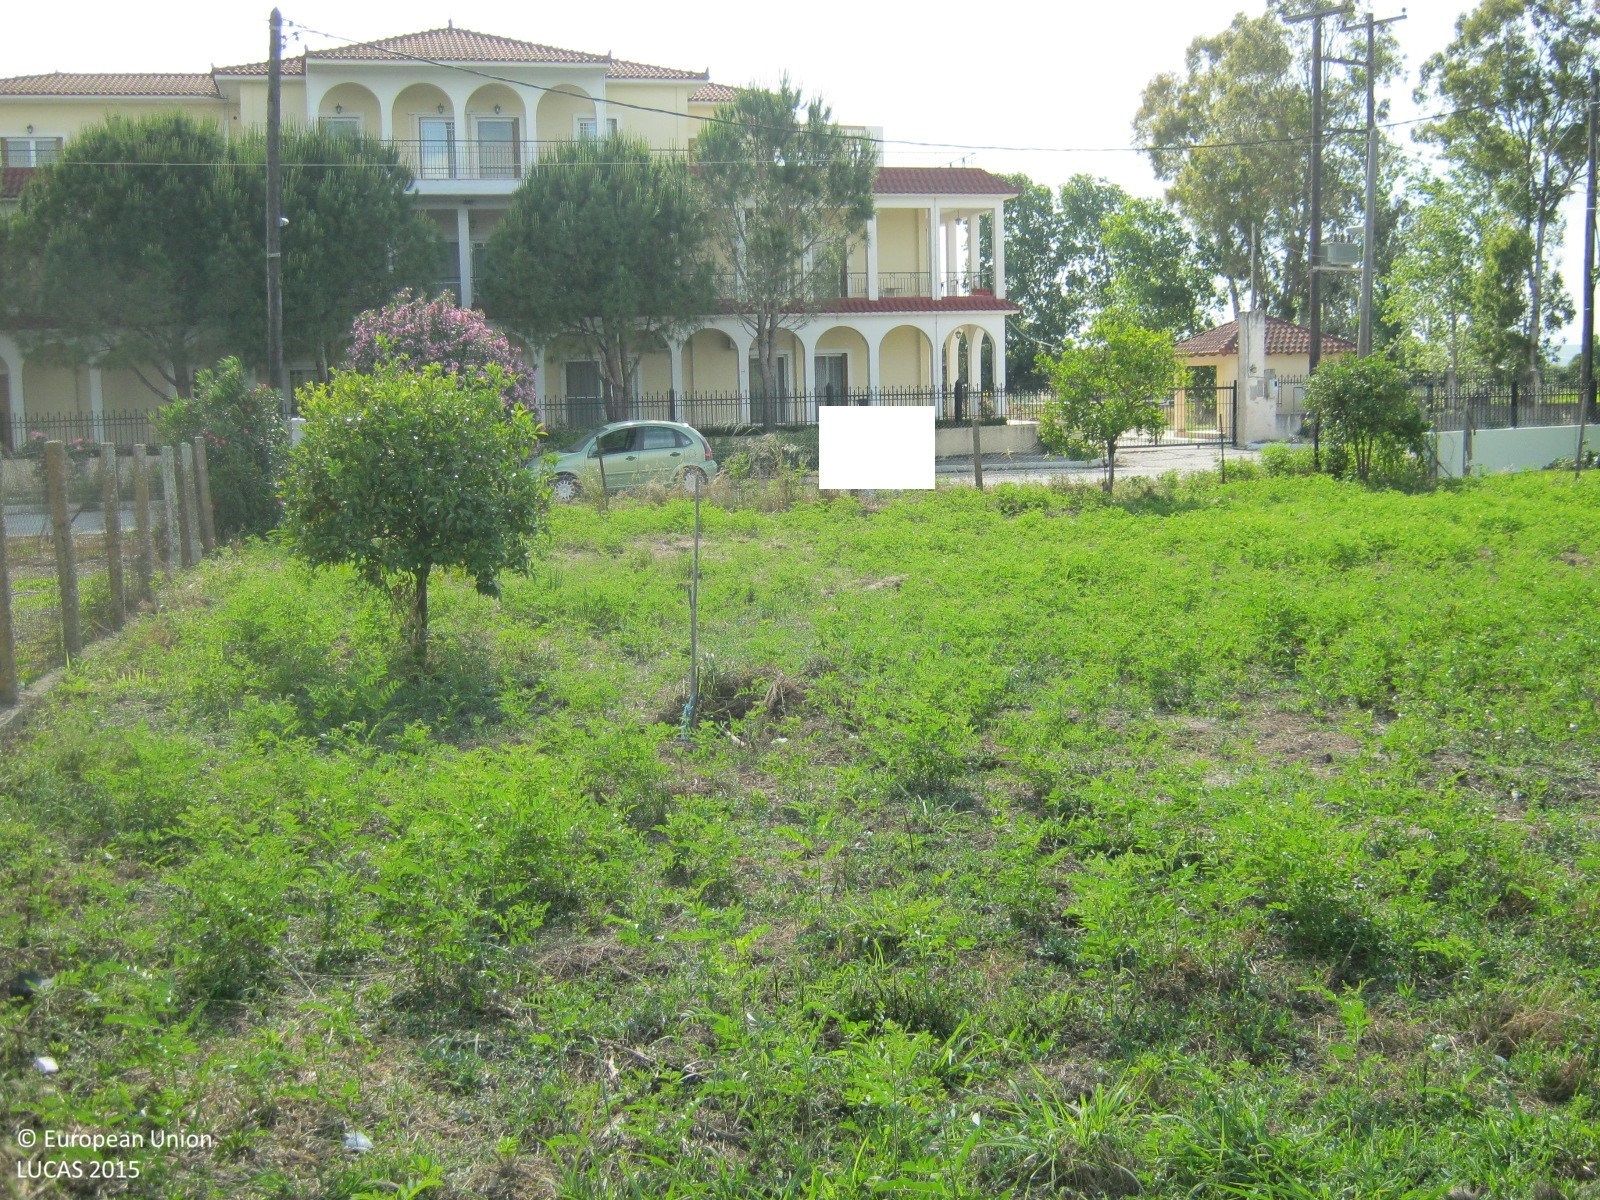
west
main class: Cropland
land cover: Oranges
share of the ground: 10 - 25 %
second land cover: Spontaneously vegetated surfaces
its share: > 75 %
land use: Kitchen garden
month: May
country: GR
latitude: 37.8466
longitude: 21.2446
